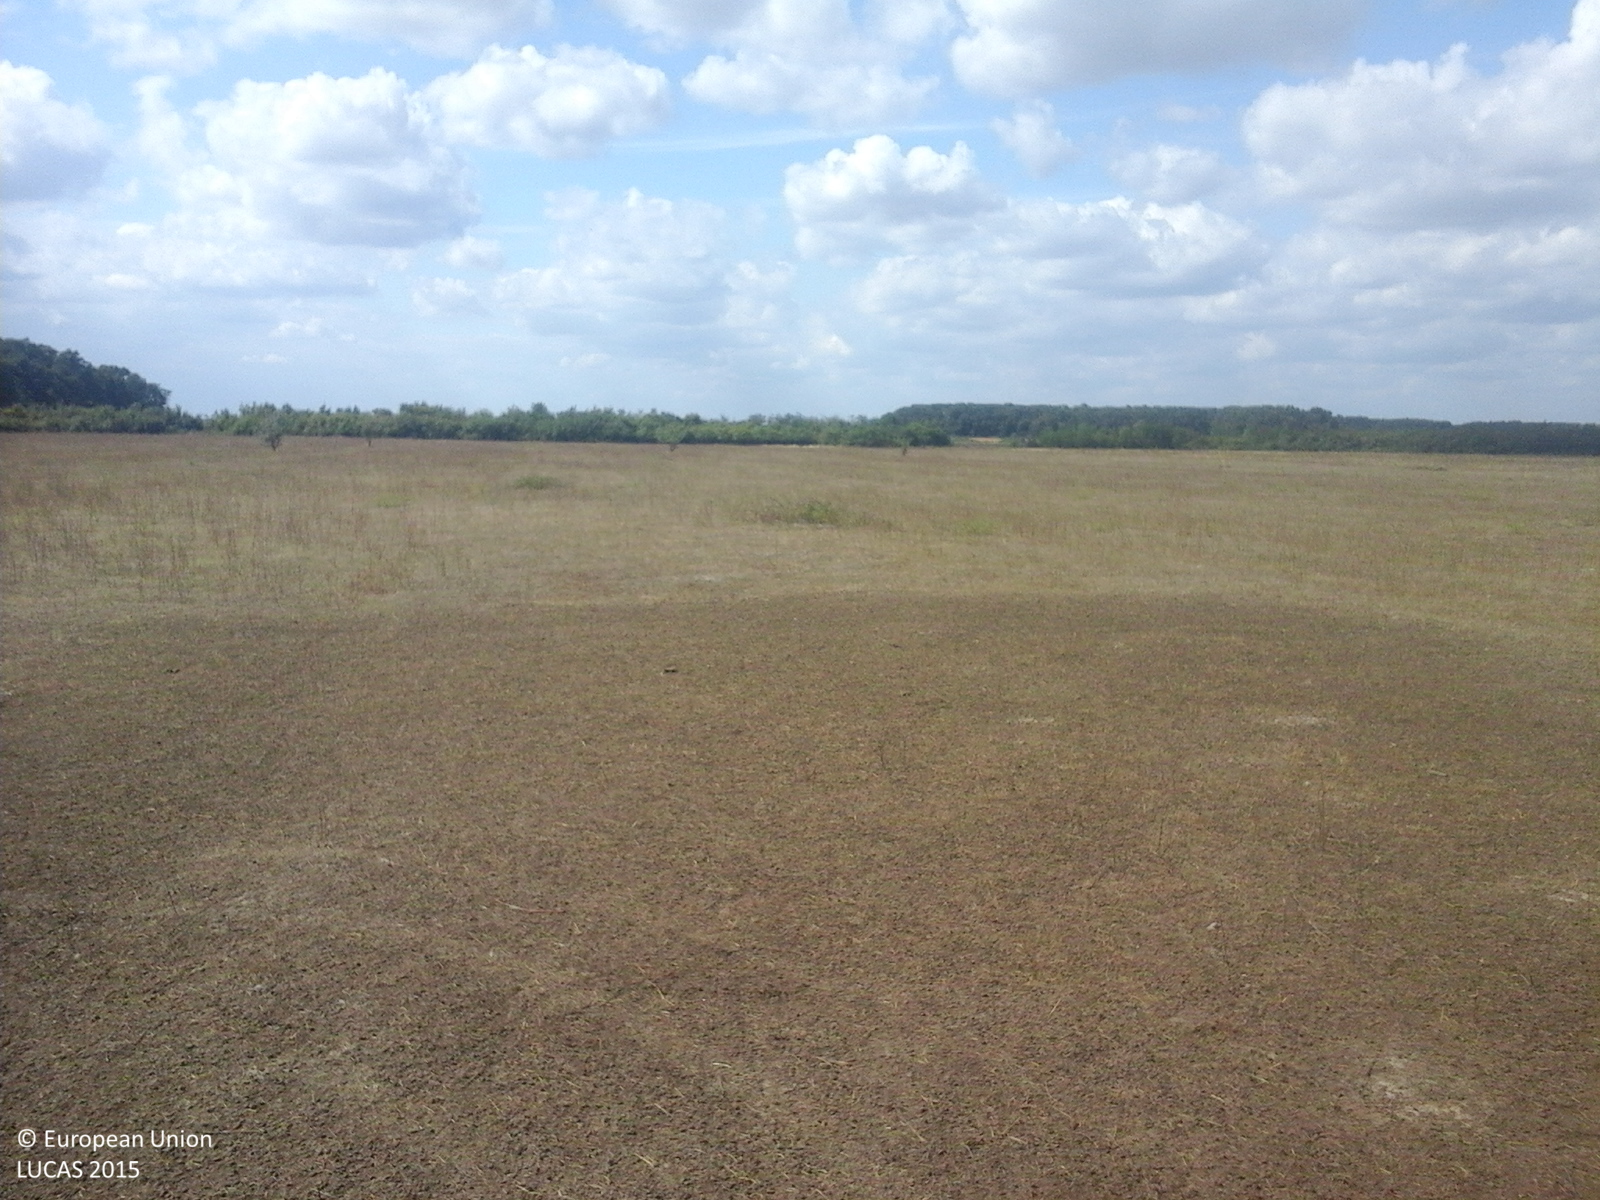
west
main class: Grassland
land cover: Grassland without tree/shrub cover
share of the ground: > 75 %
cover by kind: herbaceous plants 100 %
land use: Agriculture (excluding fallow land and kitchen gardens)
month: September
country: RO
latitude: 47.8790
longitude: 22.9156
